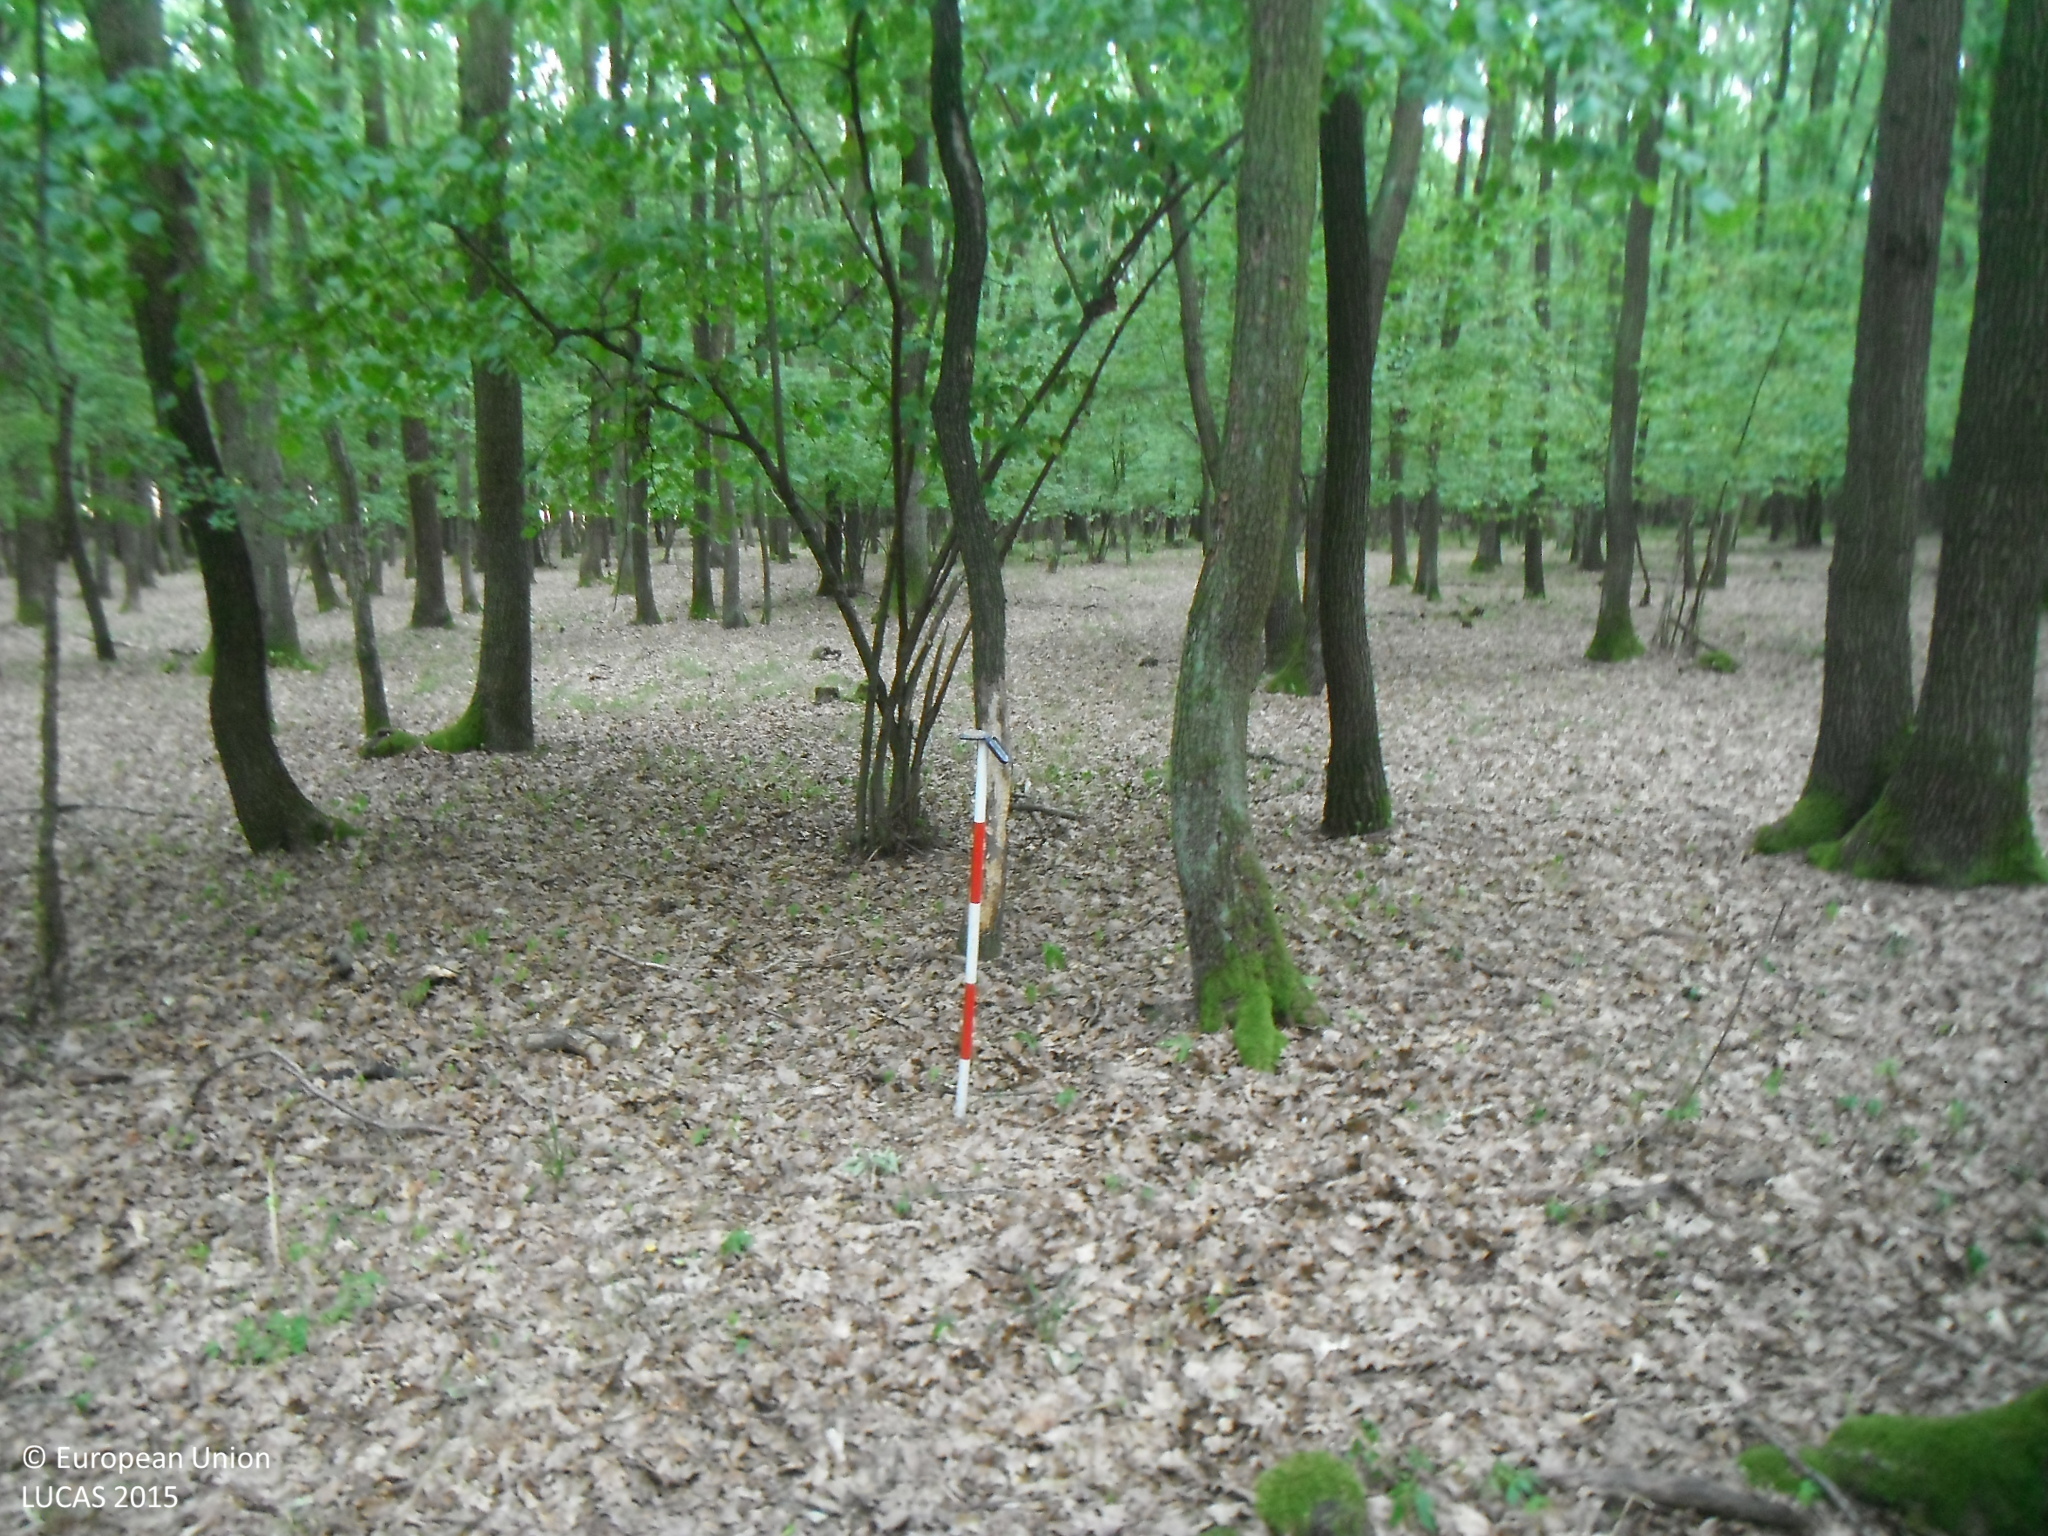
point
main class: Woodland
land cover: Broadleaved woodland
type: mesophytic deciduous forest
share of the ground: > 75 %
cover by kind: broadleaved forest trees 90 %, herbaceous plants 5 %, unconsolidated bare surface 5 %
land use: Forestry
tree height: > 5 m
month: July
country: SK
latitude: 48.7965
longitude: 17.2659
